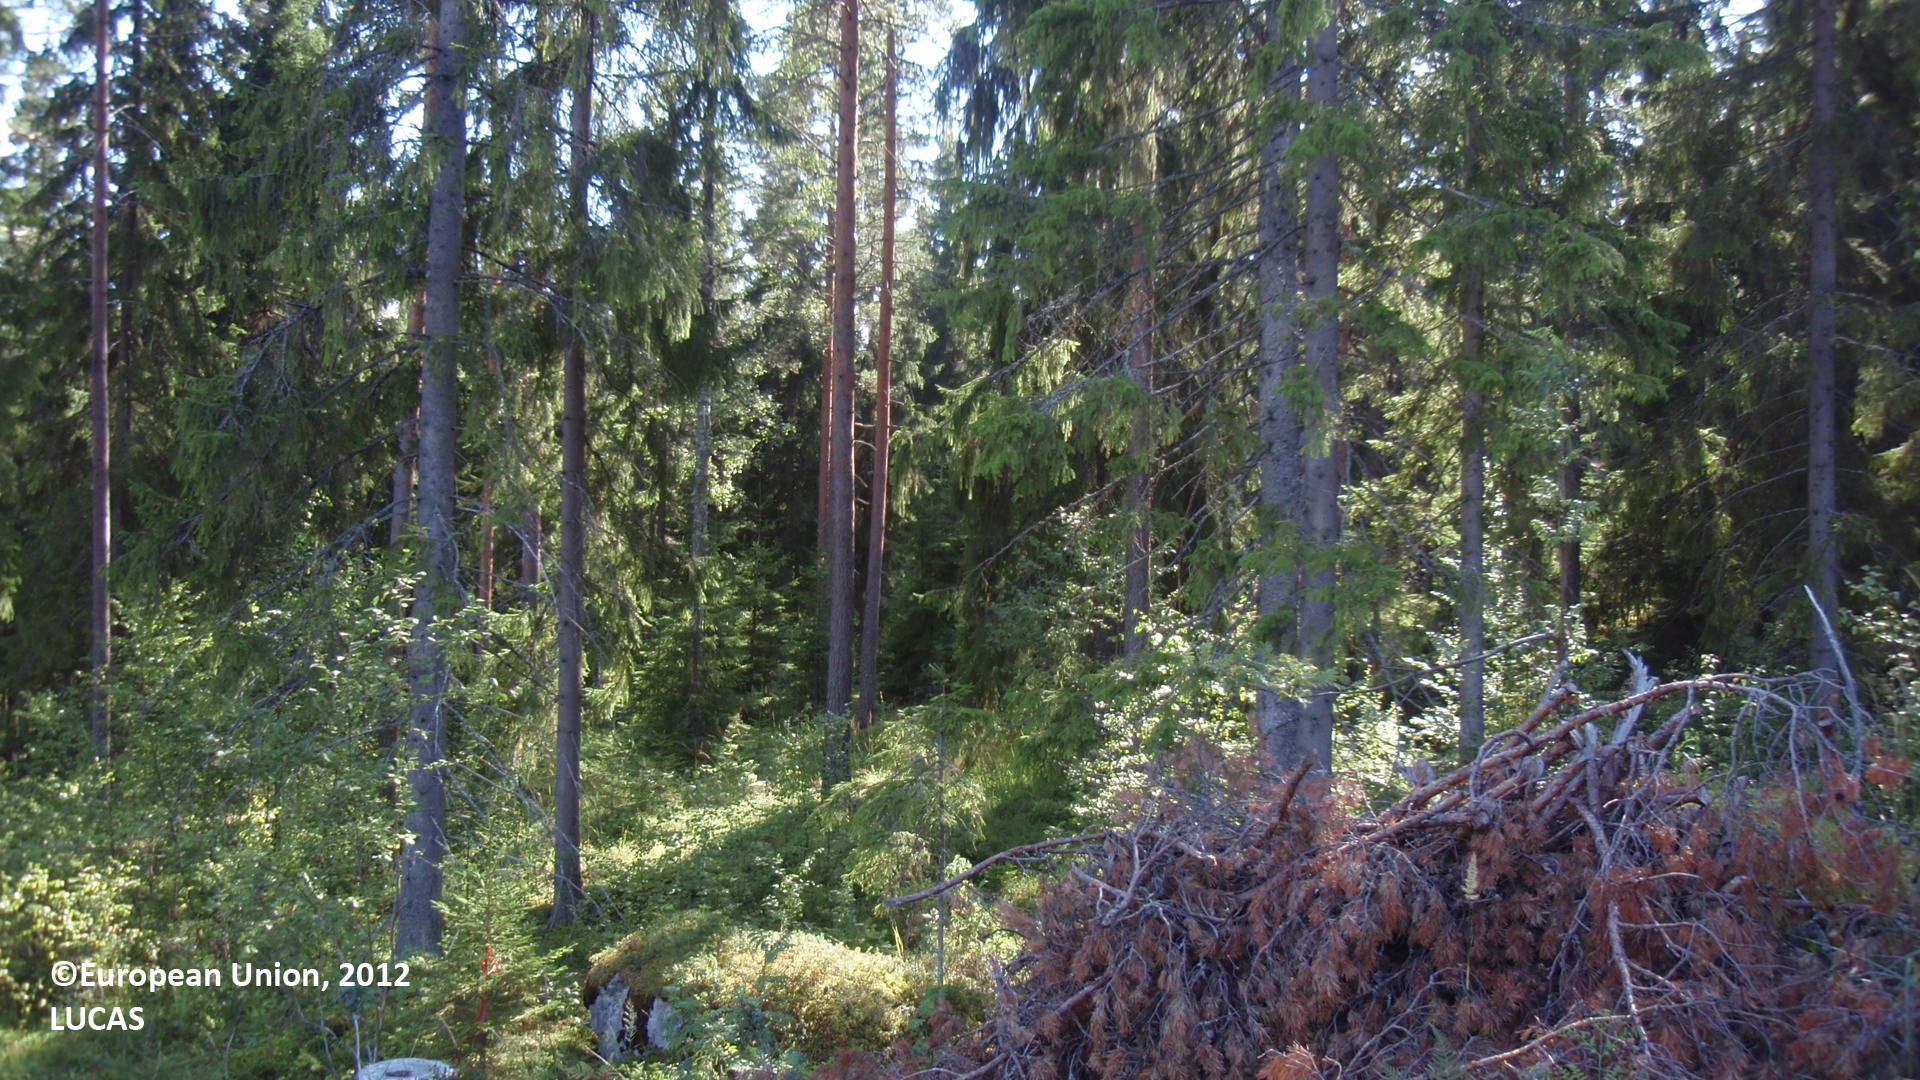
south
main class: Grassland
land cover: Grassland with sparse tree/shrub cover
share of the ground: 25 - 50 %
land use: Forestry
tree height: < 5 m
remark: Clear cut
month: July
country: FI
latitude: 61.1641
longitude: 28.2540
